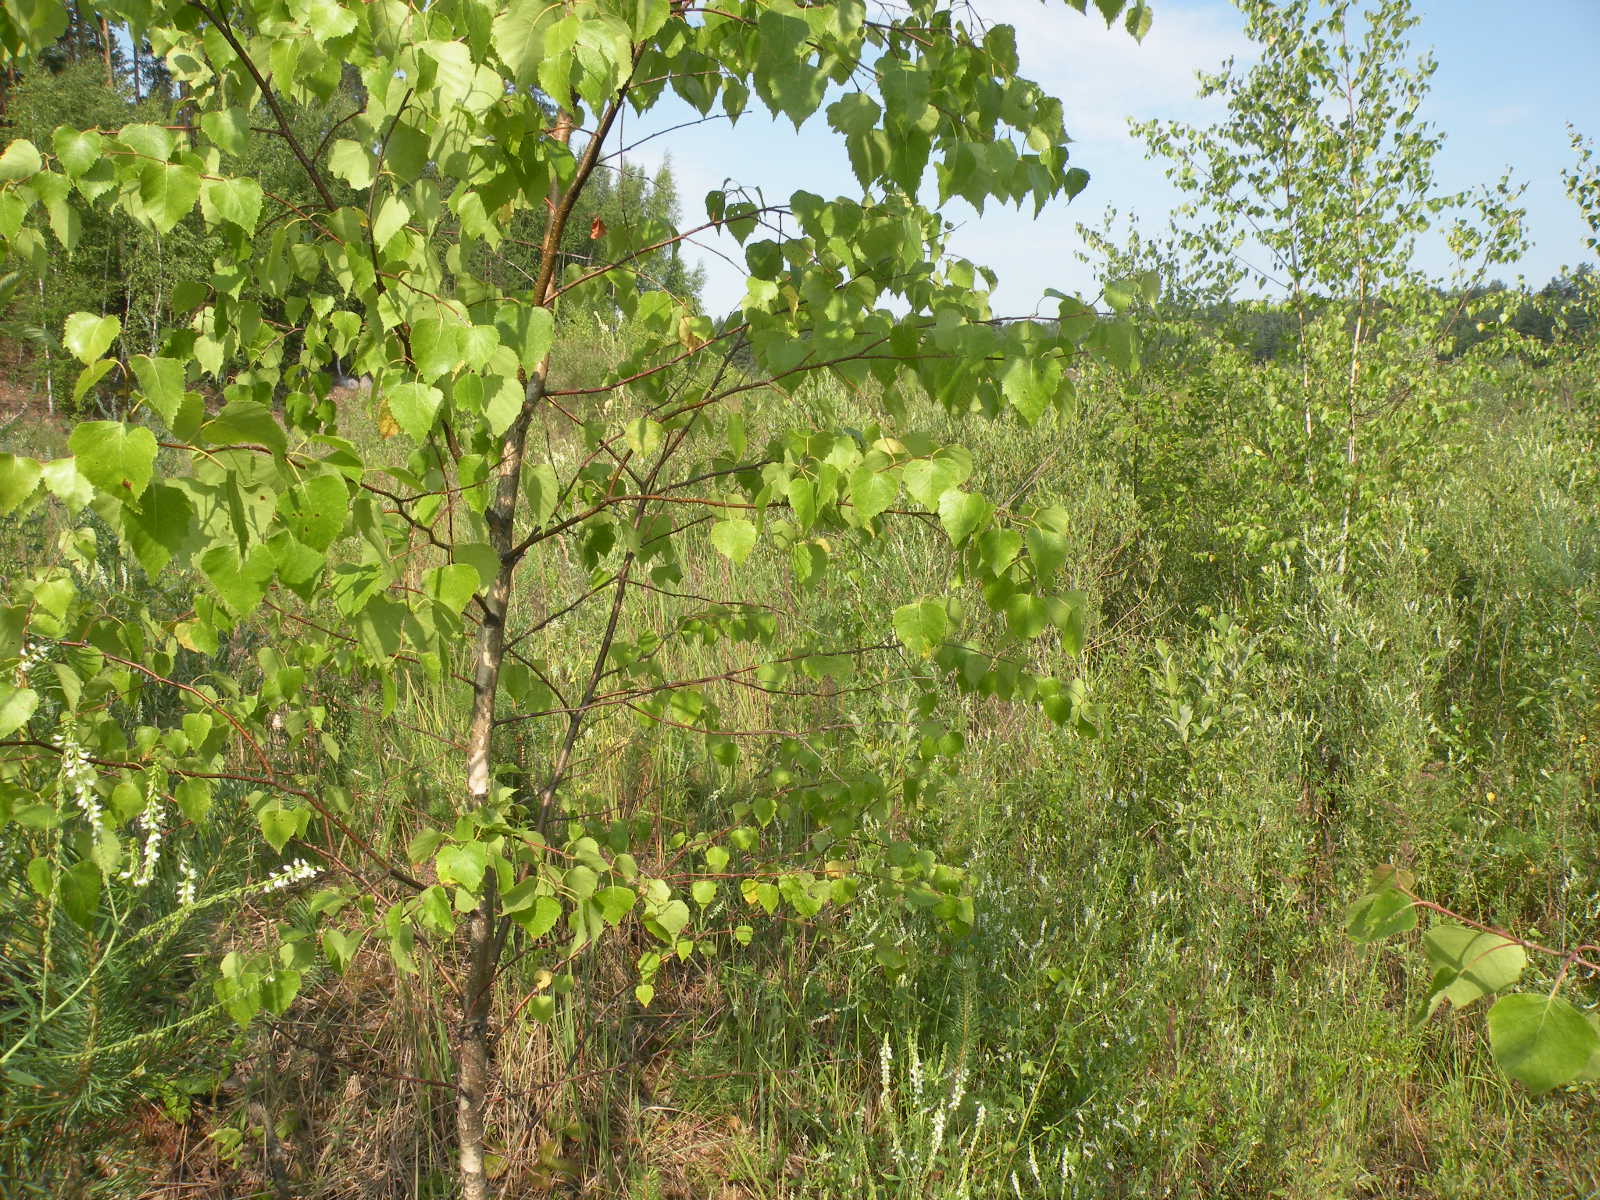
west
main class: Grassland
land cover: Grassland with sparse tree/shrub cover
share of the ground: > 75 %
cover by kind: herbaceous plants 90 %, broadleaved forest trees 5 %, shrubs 5 %
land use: Abandoned areas
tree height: < 5 m
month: July
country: LV
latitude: 55.9081
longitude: 26.7136
